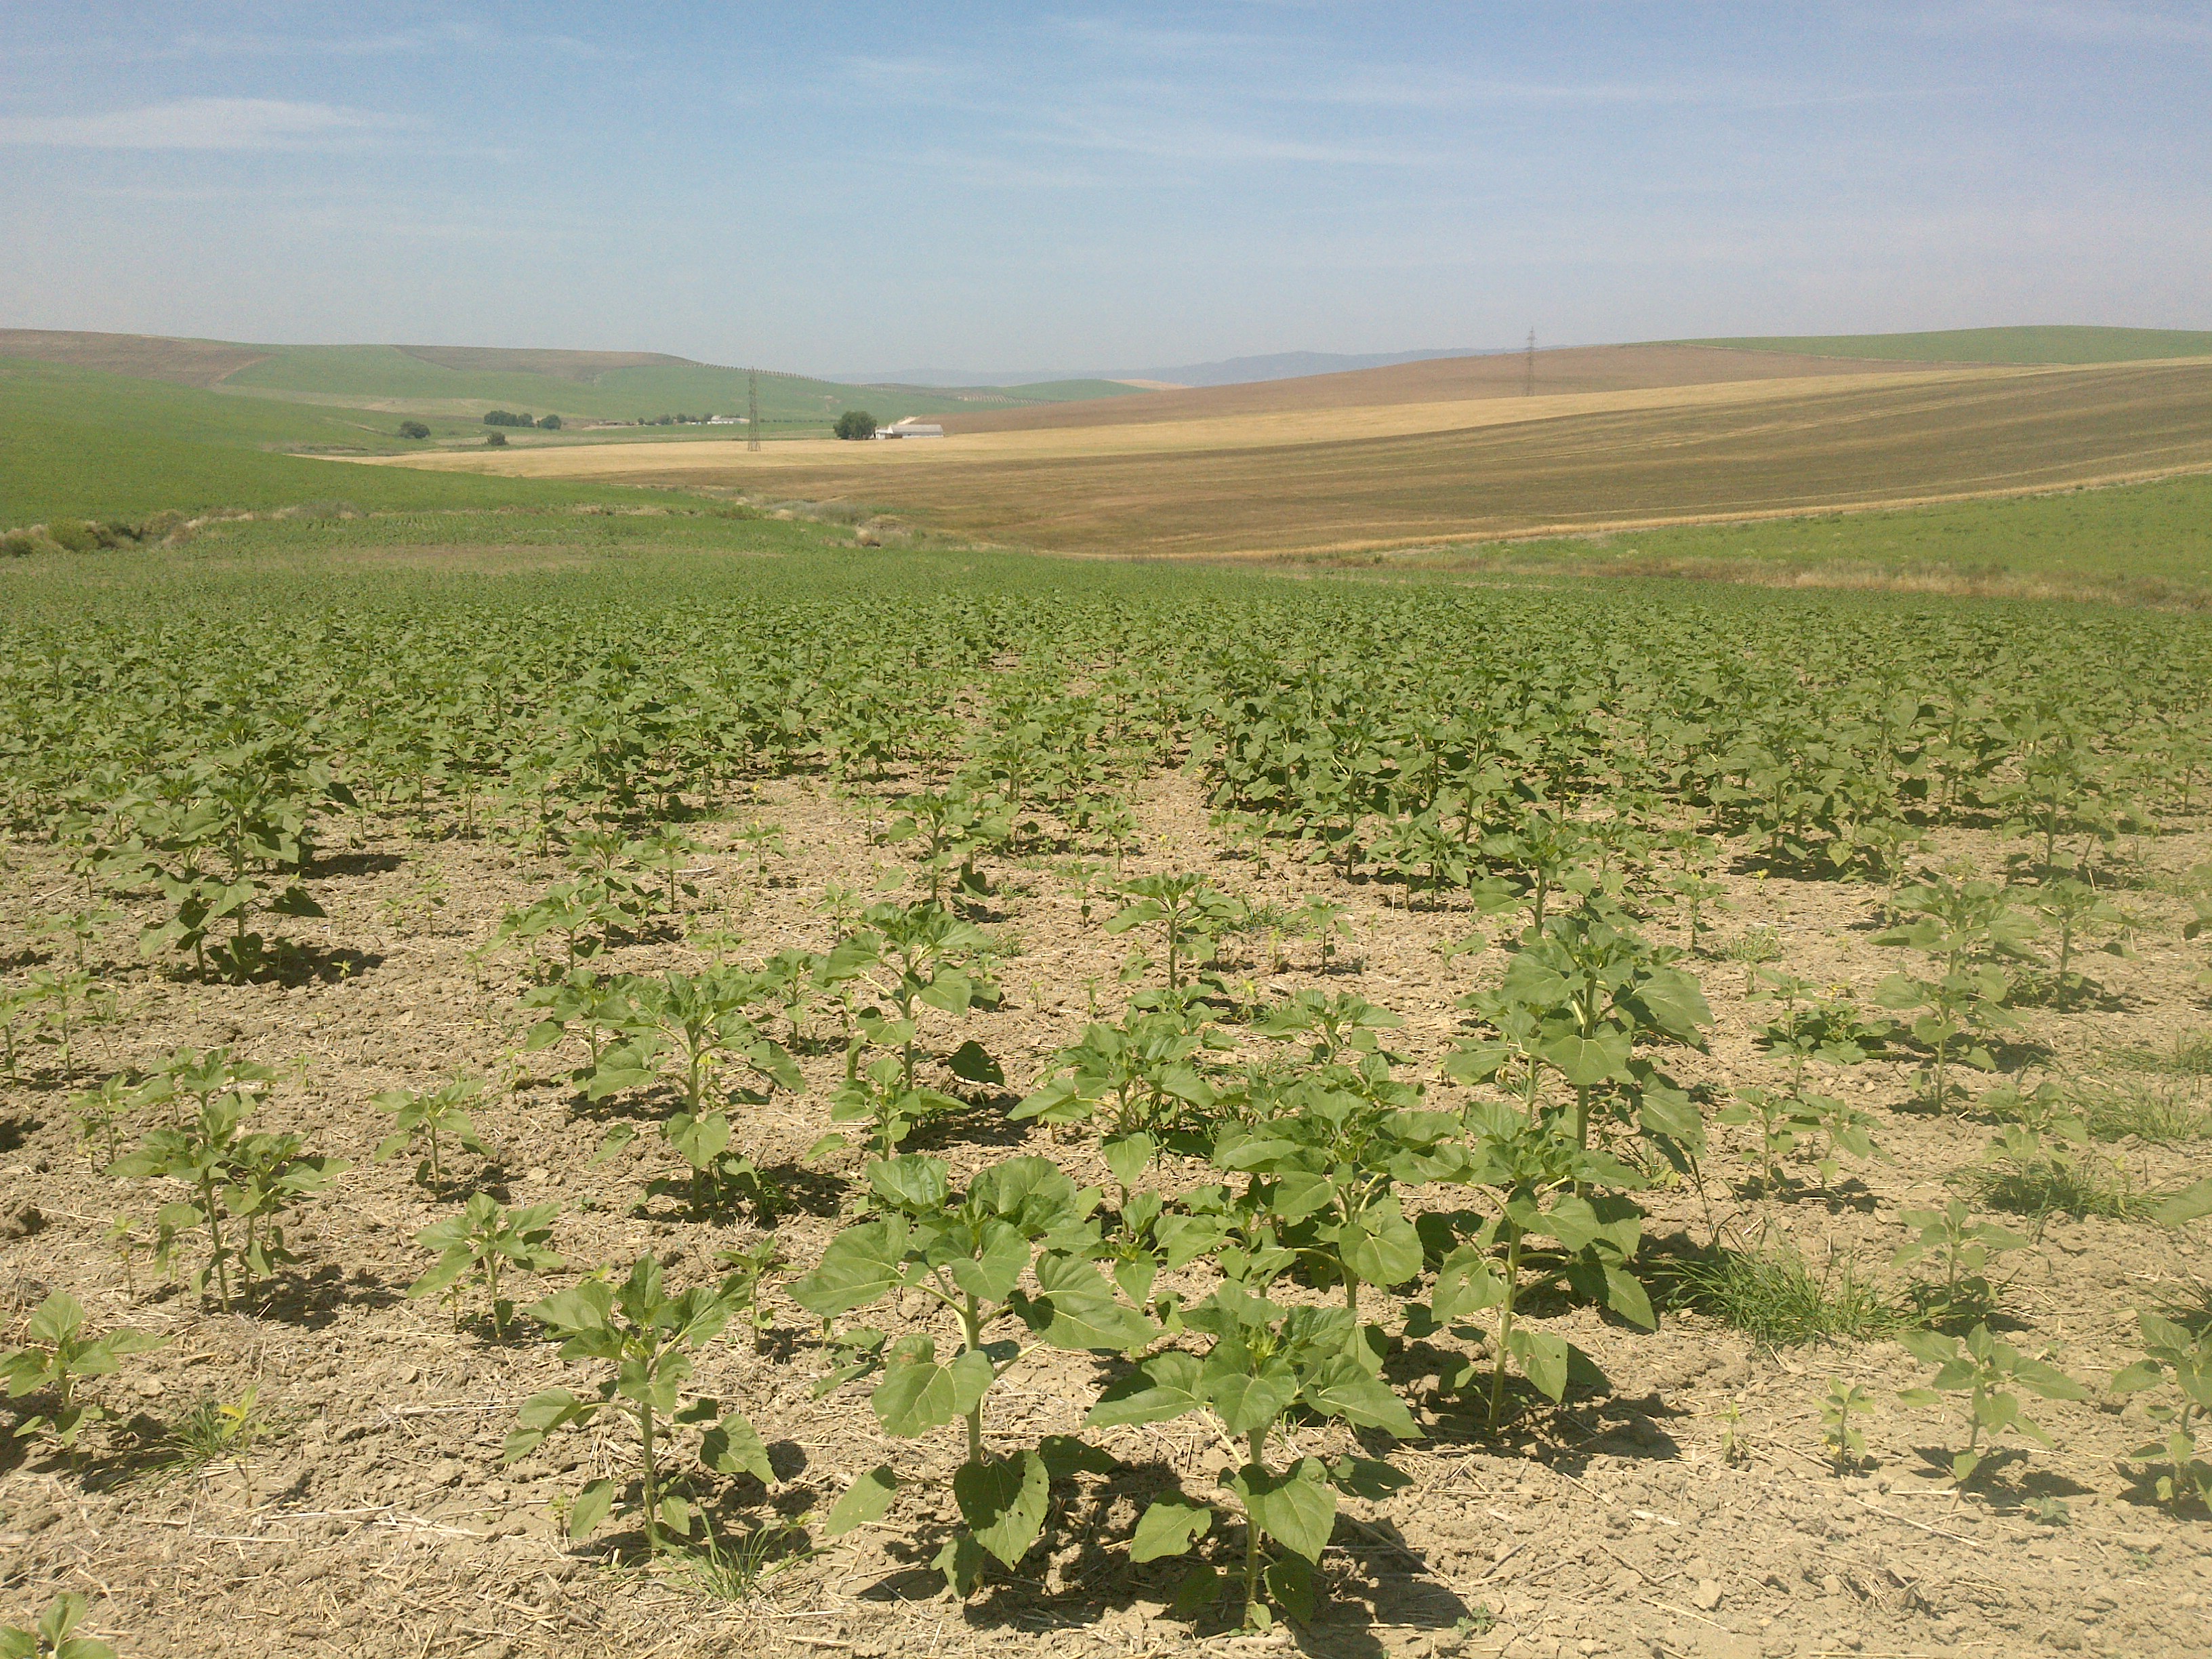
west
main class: Cropland
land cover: Sunflower
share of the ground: > 75 %
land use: Agriculture (excluding fallow land and kitchen gardens)
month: May
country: ES
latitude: 37.8548
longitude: -4.6625
